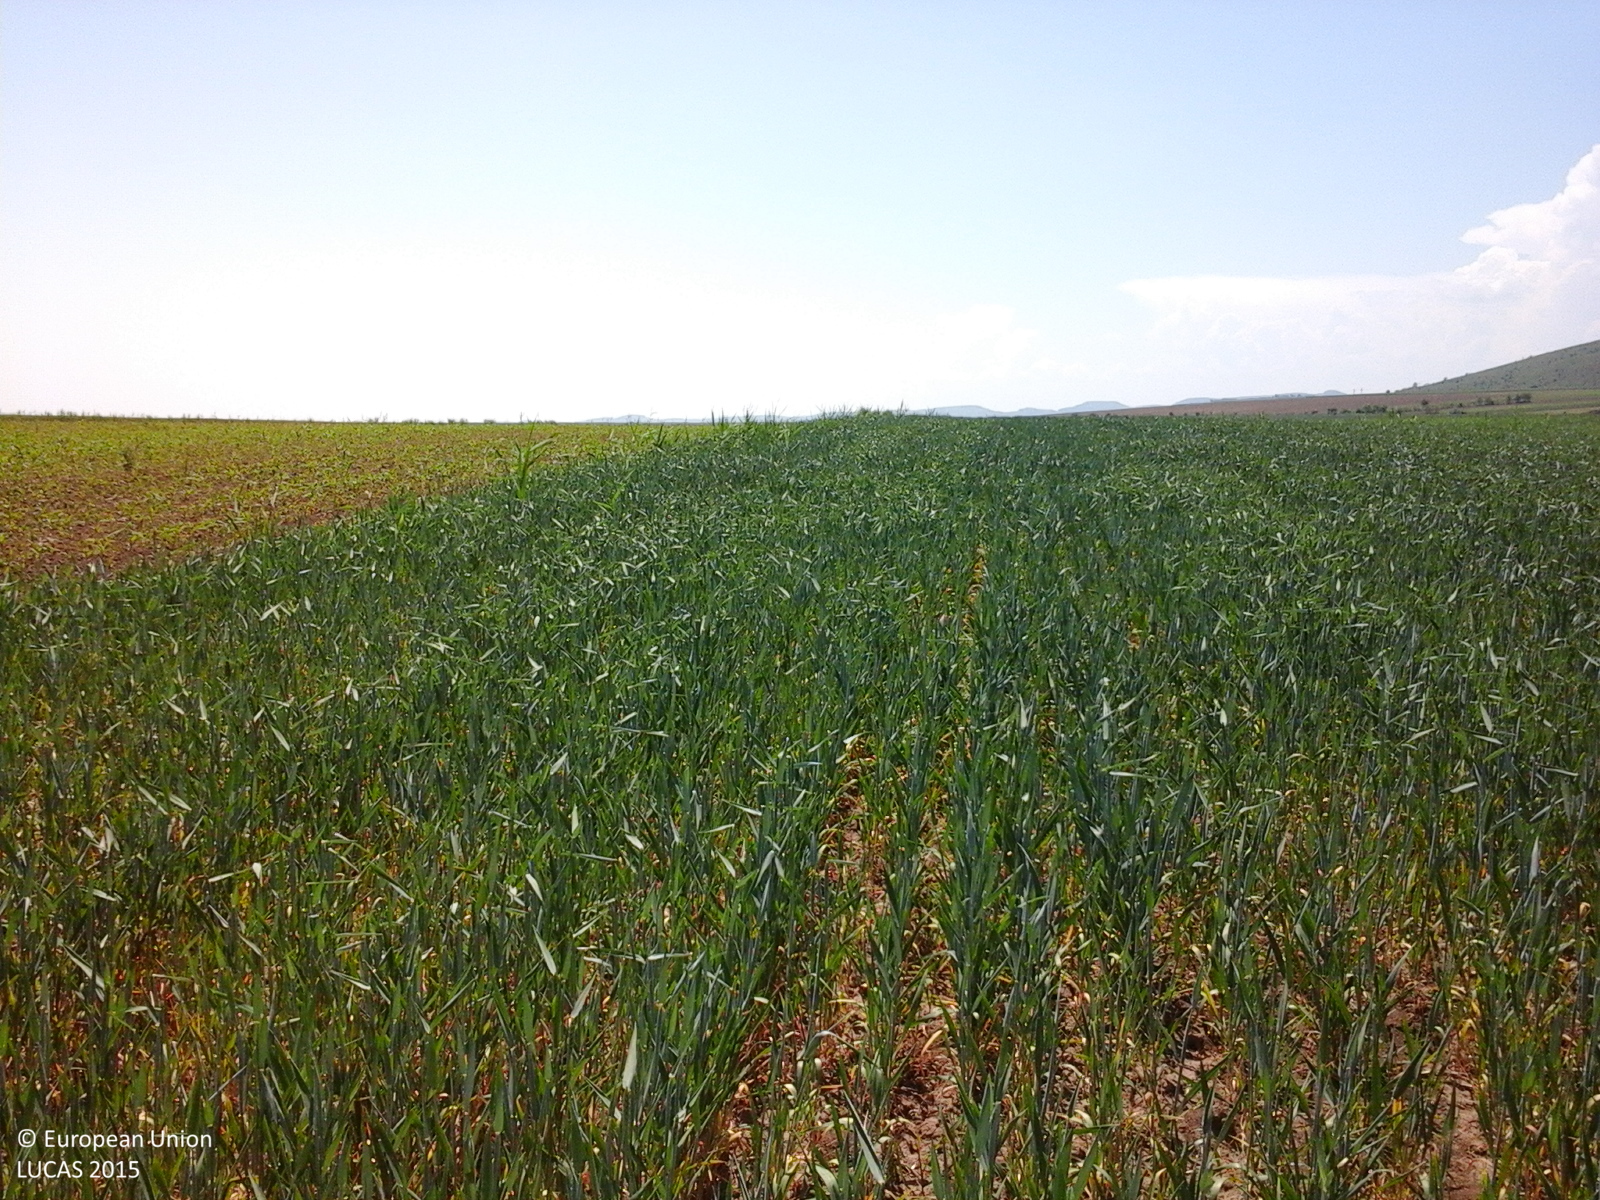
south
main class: Cropland
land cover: Common wheat
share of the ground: > 75 %
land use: Agriculture (excluding fallow land and kitchen gardens)
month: June
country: RO
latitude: 46.5032
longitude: 26.8898
